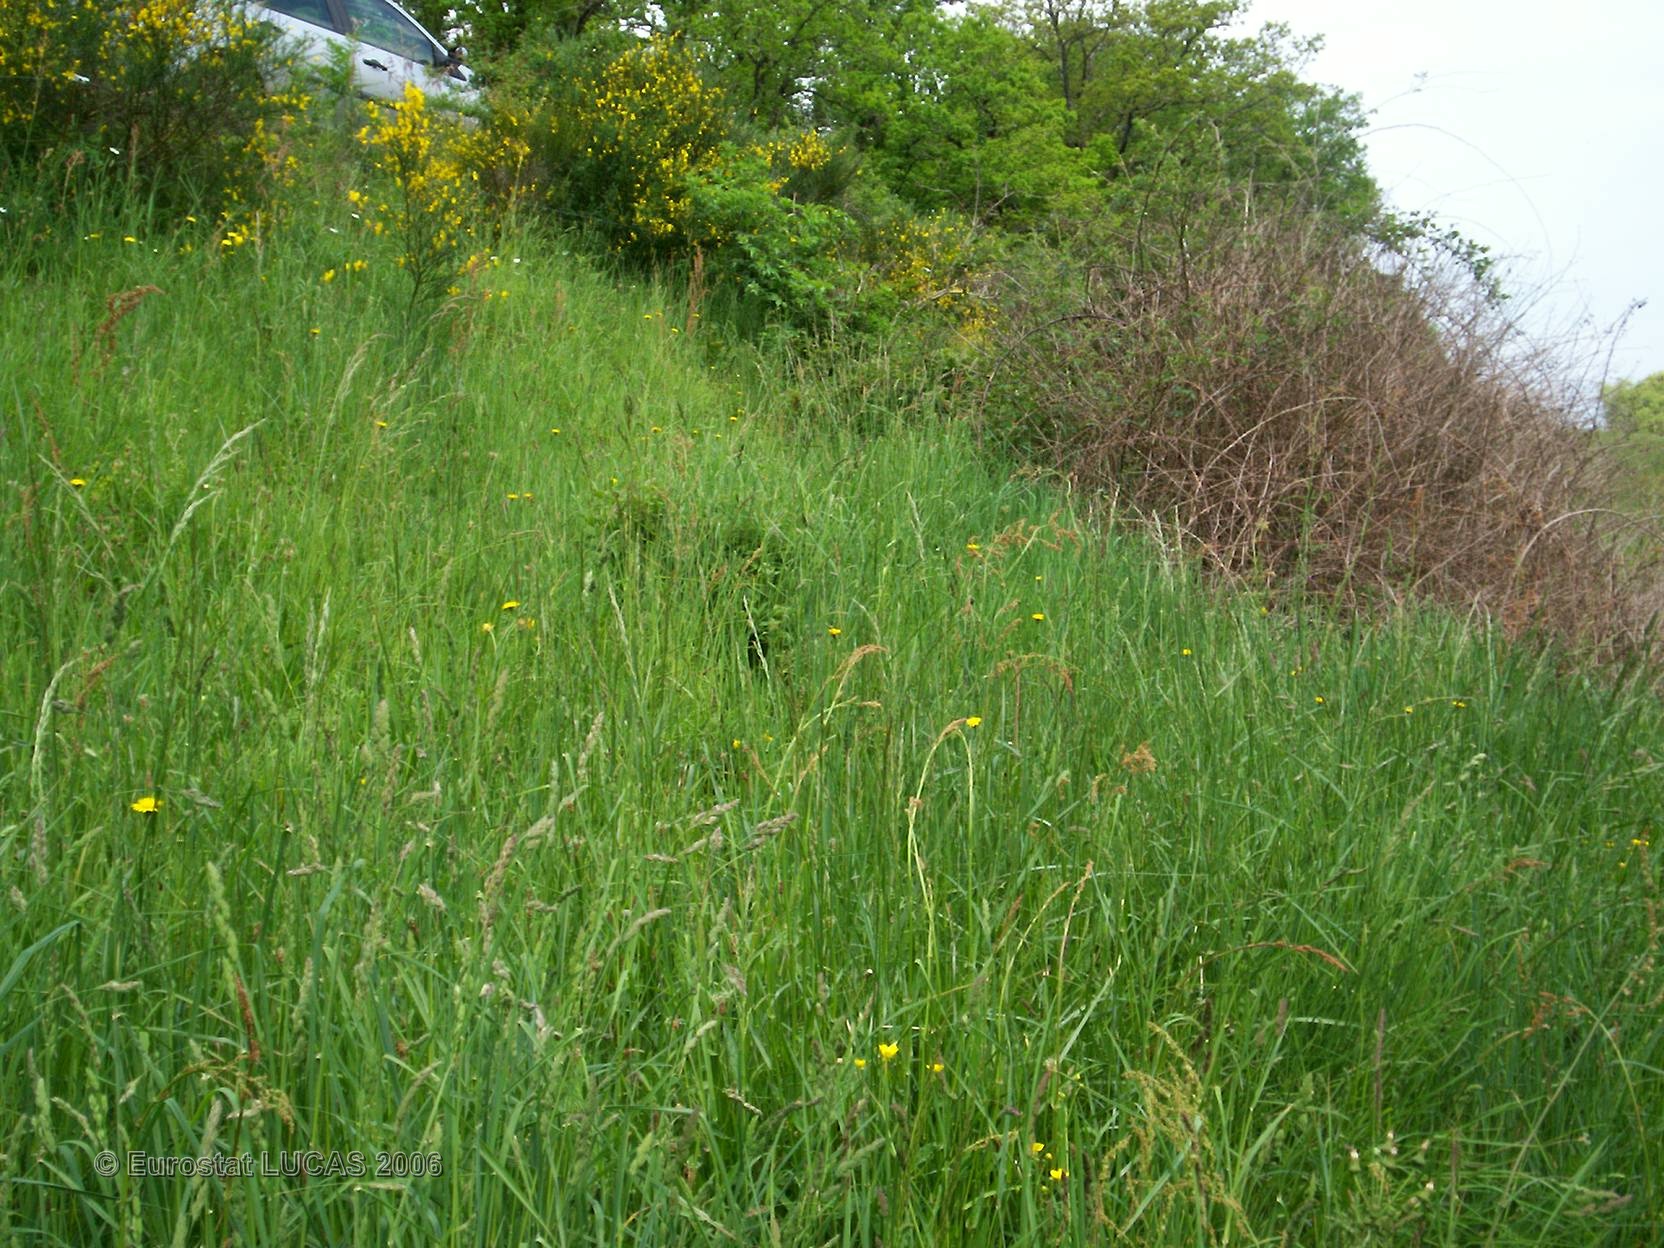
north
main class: Grassland
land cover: Grassland without tree/shrub cover
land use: Agriculture (excluding fallow land and kitchen gardens)
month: May
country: FR
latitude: 46.1202
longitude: 1.4892
